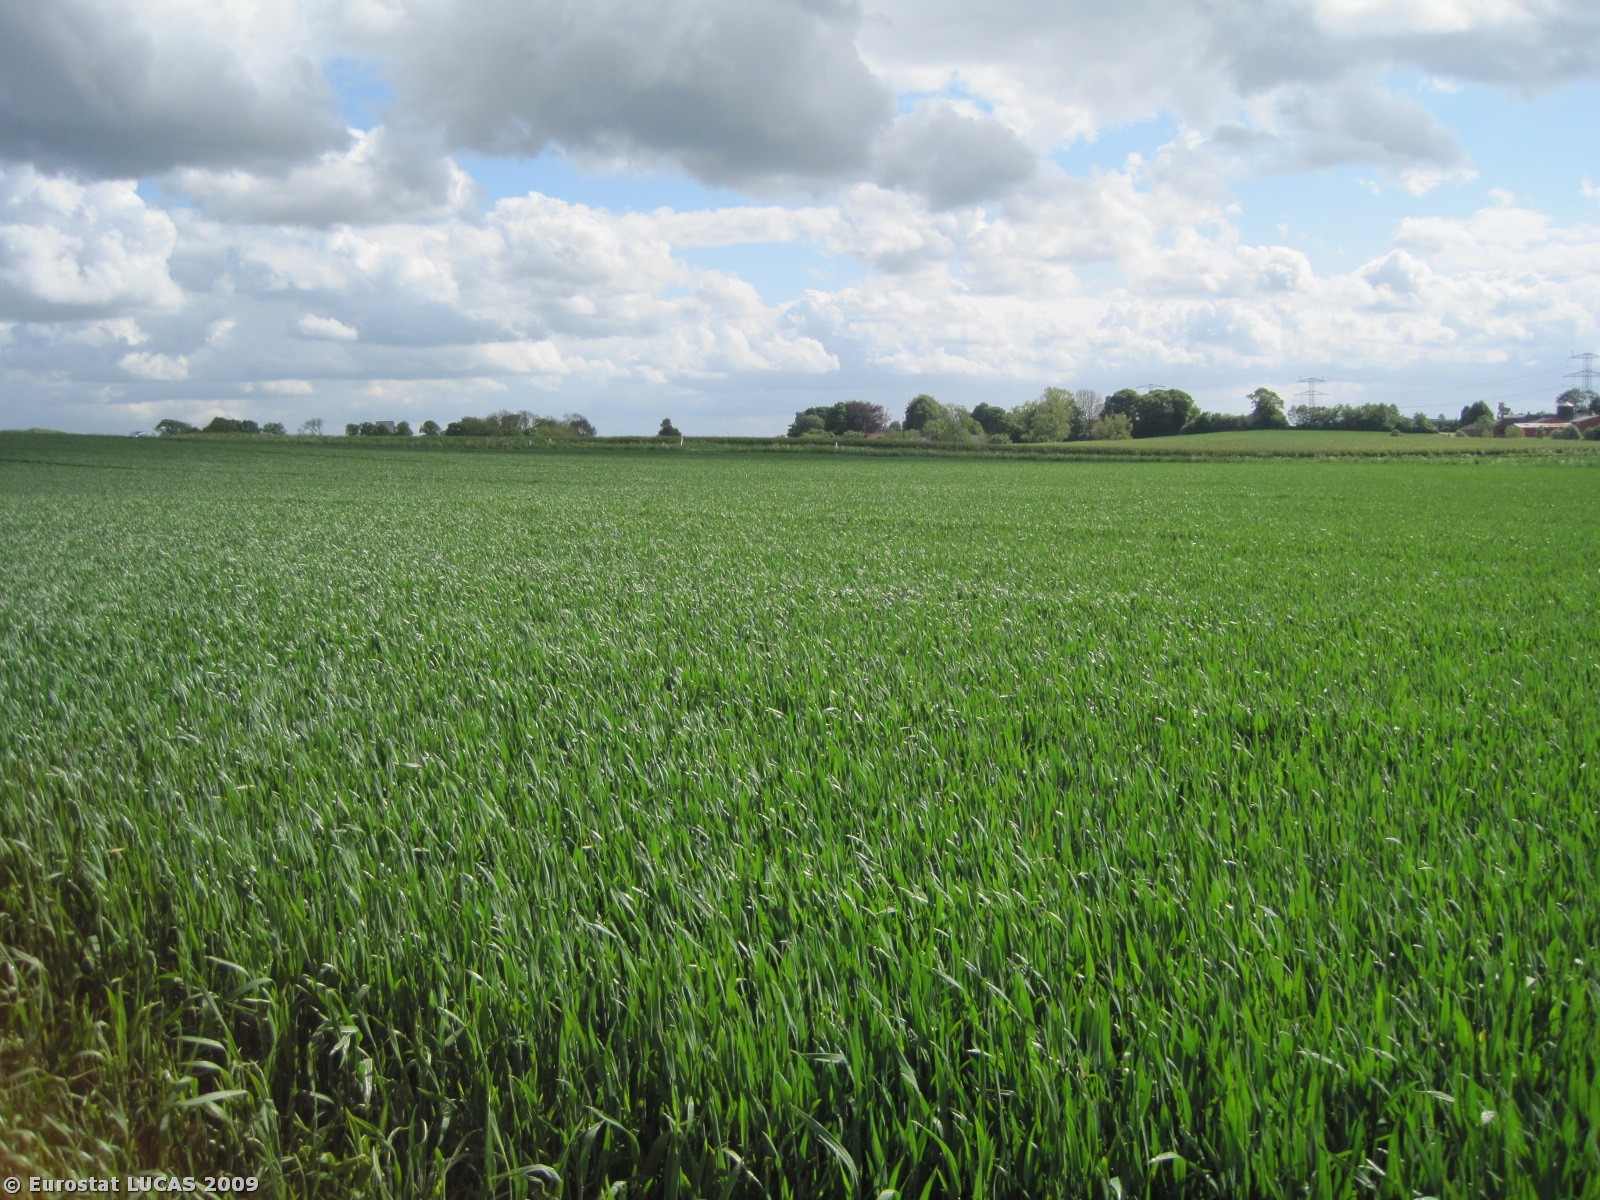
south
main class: Cropland
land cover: Common wheat
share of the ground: > 75 %
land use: Agriculture (excluding fallow land and kitchen gardens)
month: May
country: DK
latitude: 56.5113
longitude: 9.9838
